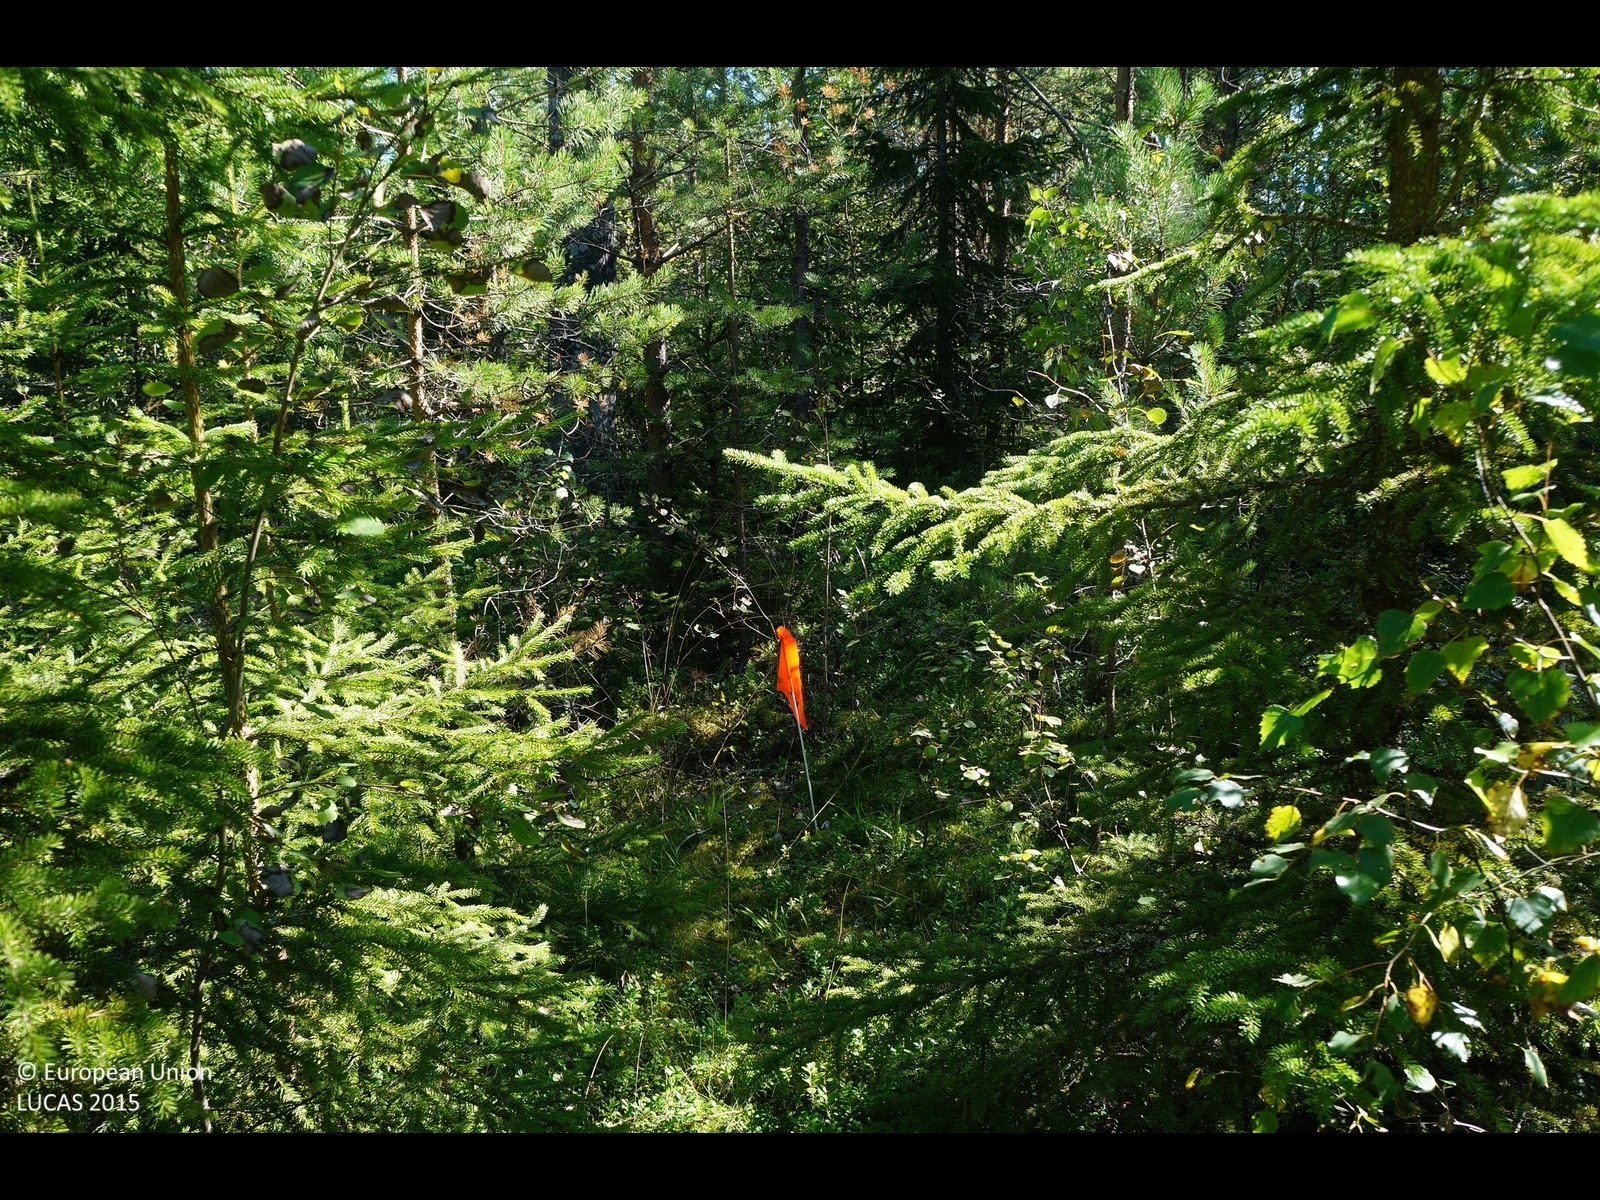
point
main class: Woodland
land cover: Other mixed woodland
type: boreal forest
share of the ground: 50 - 75 %
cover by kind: coniferous forest trees 50 %, shrubs 30 %, broadleaved forest trees 20 %
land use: Forestry
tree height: > 5 m
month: August
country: FI
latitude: 63.7362
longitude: 22.9539
